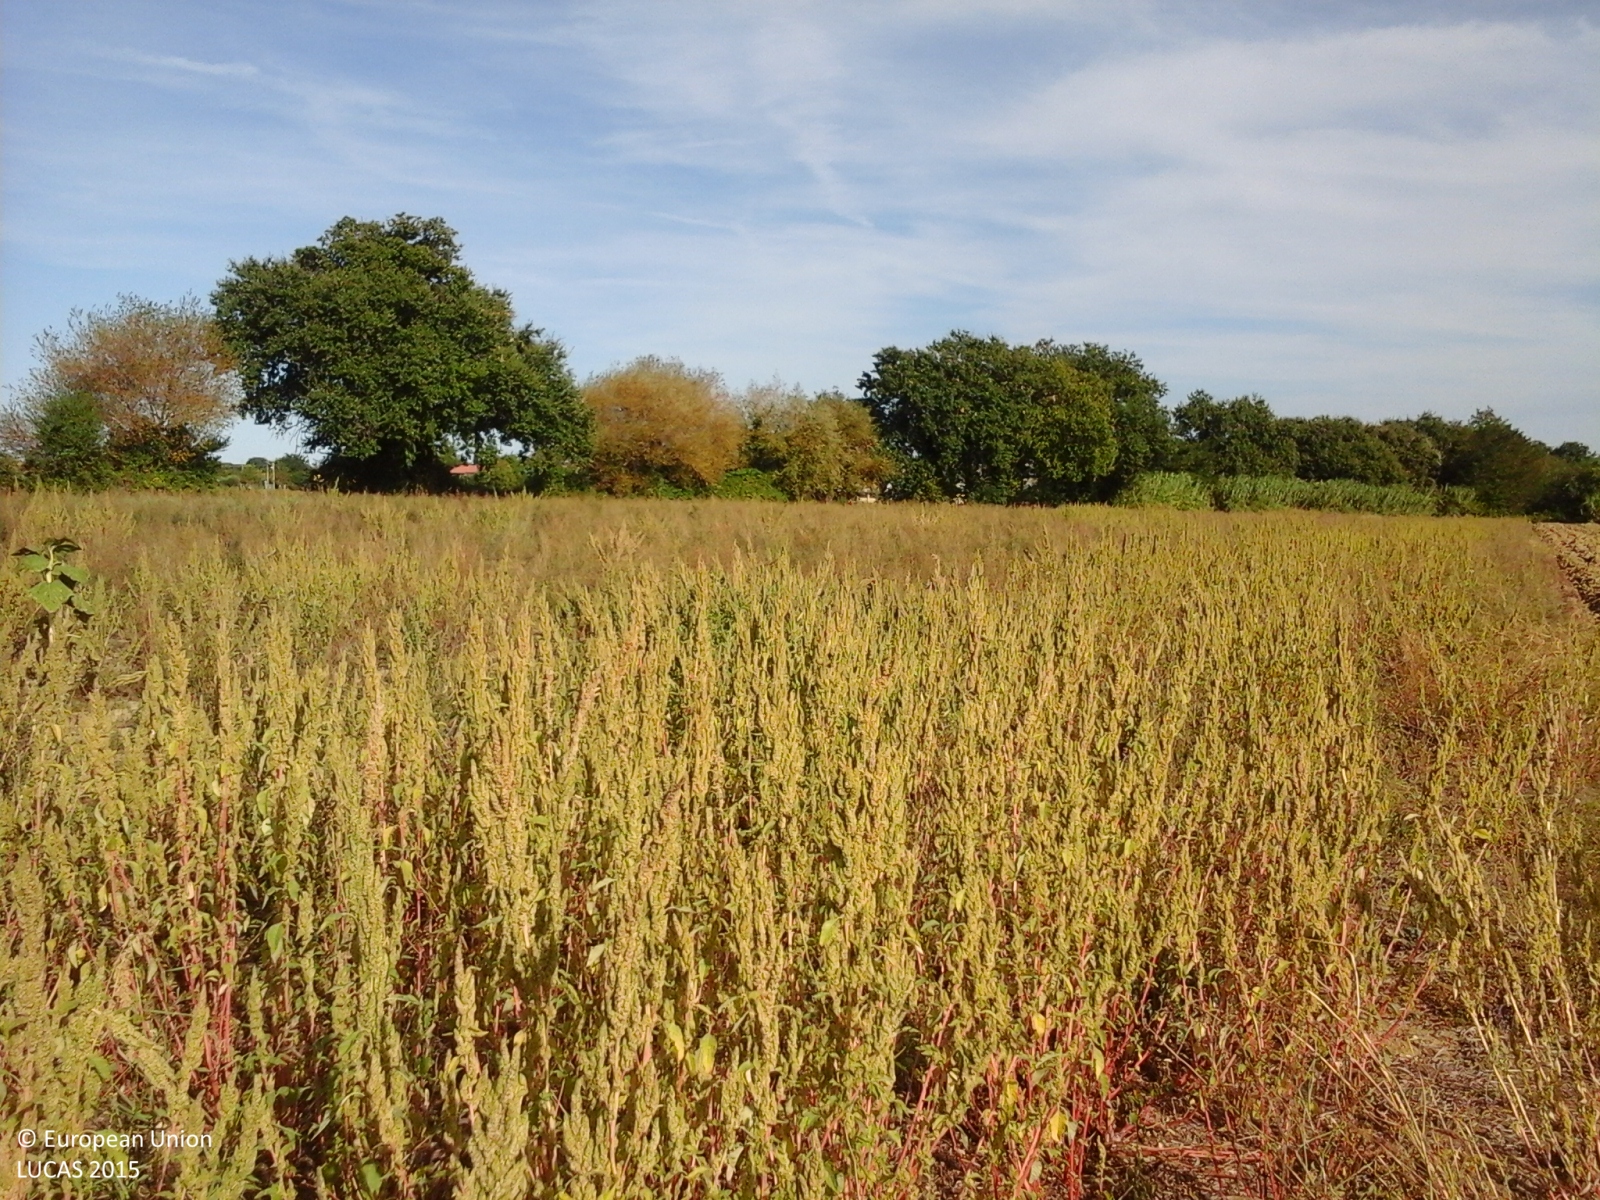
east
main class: Grassland
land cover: Spontaneously vegetated surfaces
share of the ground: > 75 %
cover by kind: herbaceous plants 100 %
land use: Fallow land
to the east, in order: Spontaneously vegetated surfaces; Broadleaved woodland; Spontaneously vegetated surfaces
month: September
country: IT
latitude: 43.7675
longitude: 12.9371
